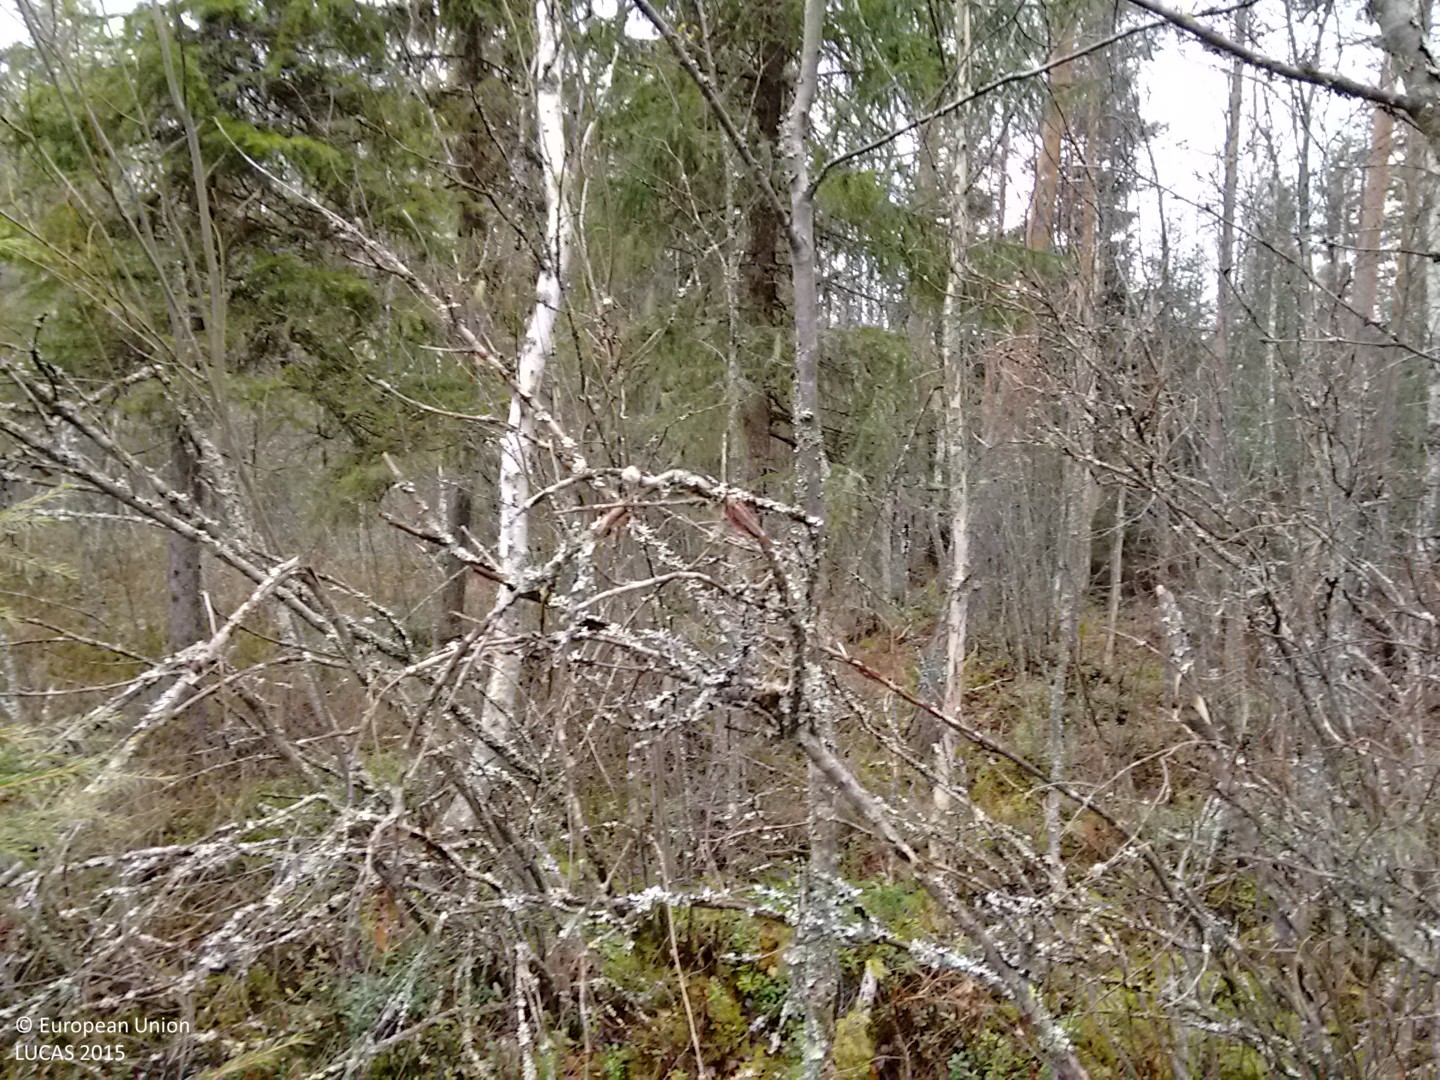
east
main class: Woodland
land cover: Other mixed woodland
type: boreal forest
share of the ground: > 75 %
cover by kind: coniferous forest trees 45 %, broadleaved forest trees 40 %, shrubs 10 %, herbaceous plants 5 %
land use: Forestry
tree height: > 5 m
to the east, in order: Other mixed woodland; Ditches and canals; Spruce dominated mixed woodland; Ditches and canals; Spruce dominated mixed woodland; Pine dominated mixed woodland; Ditches and canals; Pine dominated mixed woodland; Pine dominated coniferous woodland
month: October
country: FI
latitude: 64.5910
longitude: 25.3120
